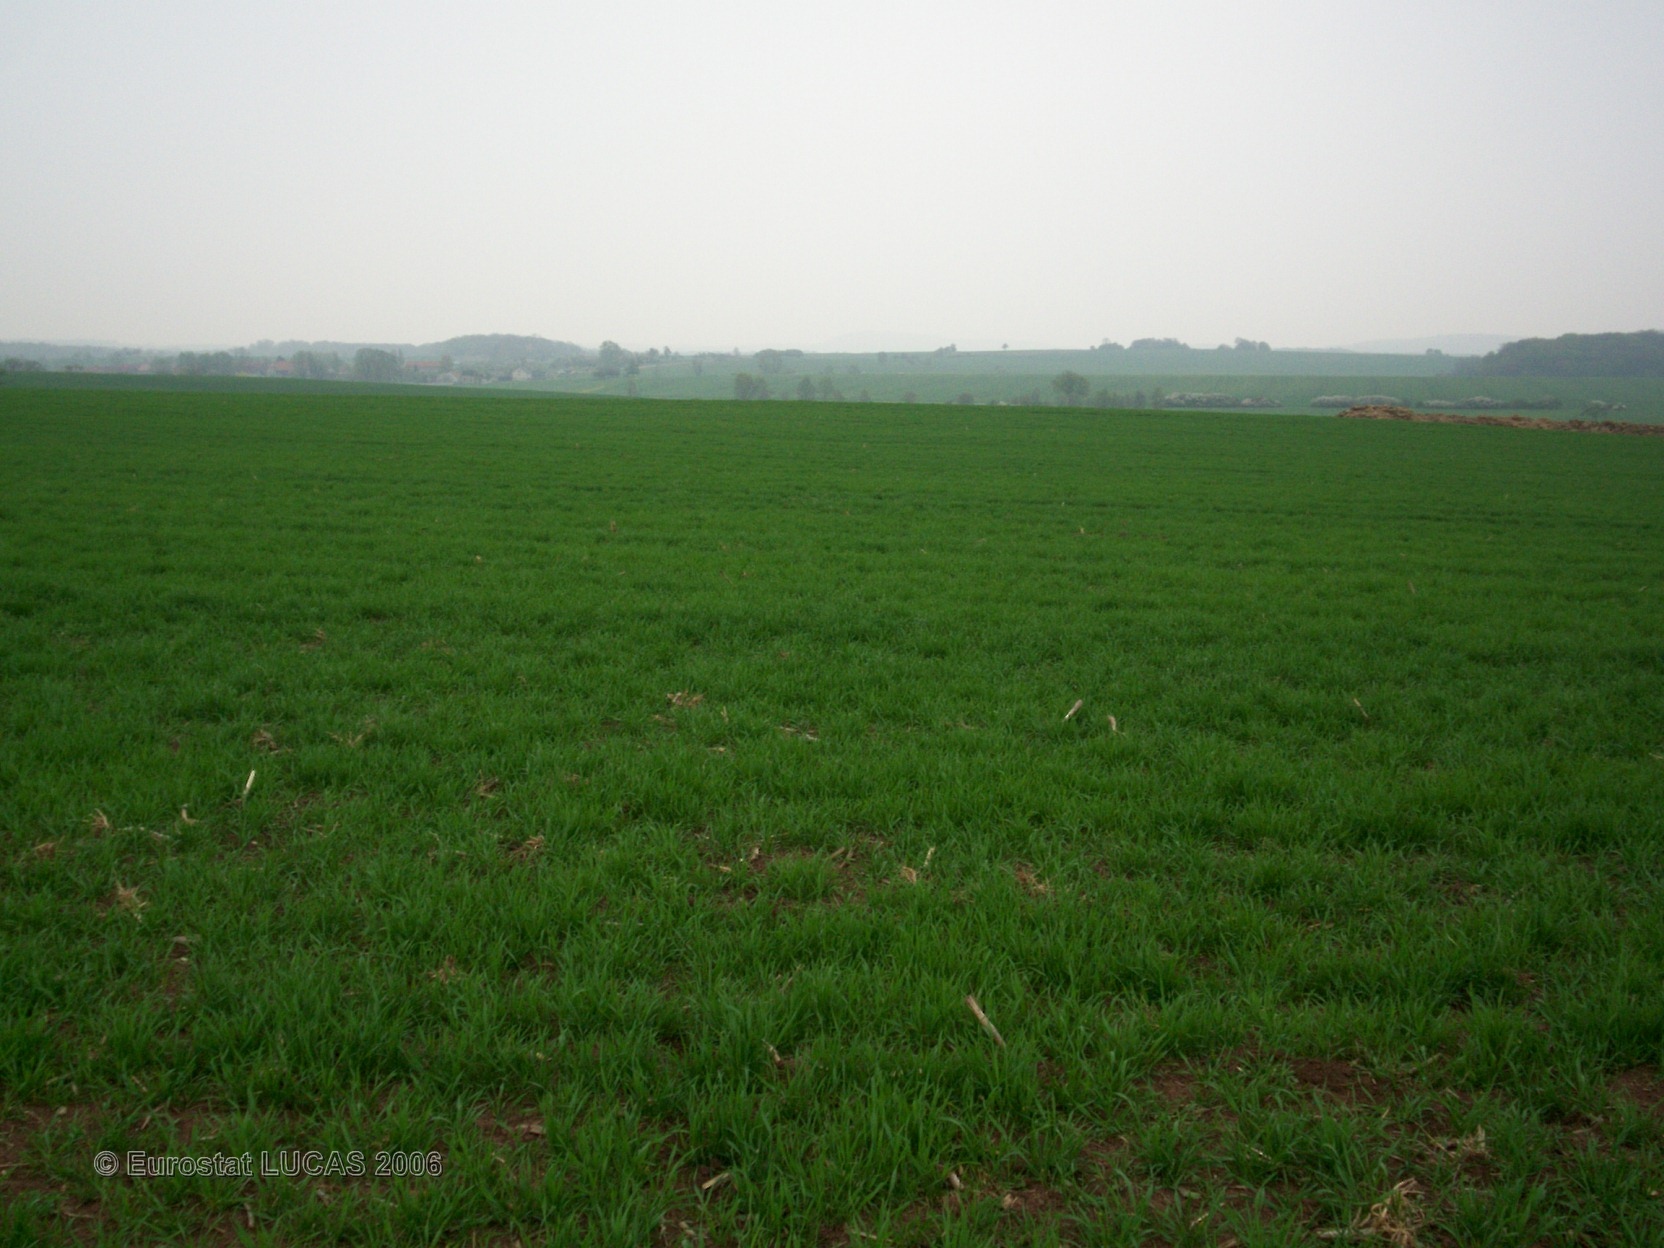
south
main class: Cropland
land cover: Common wheat
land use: Agriculture (excluding fallow land and kitchen gardens)
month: April
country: FR
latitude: 48.9496
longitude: 6.7367
